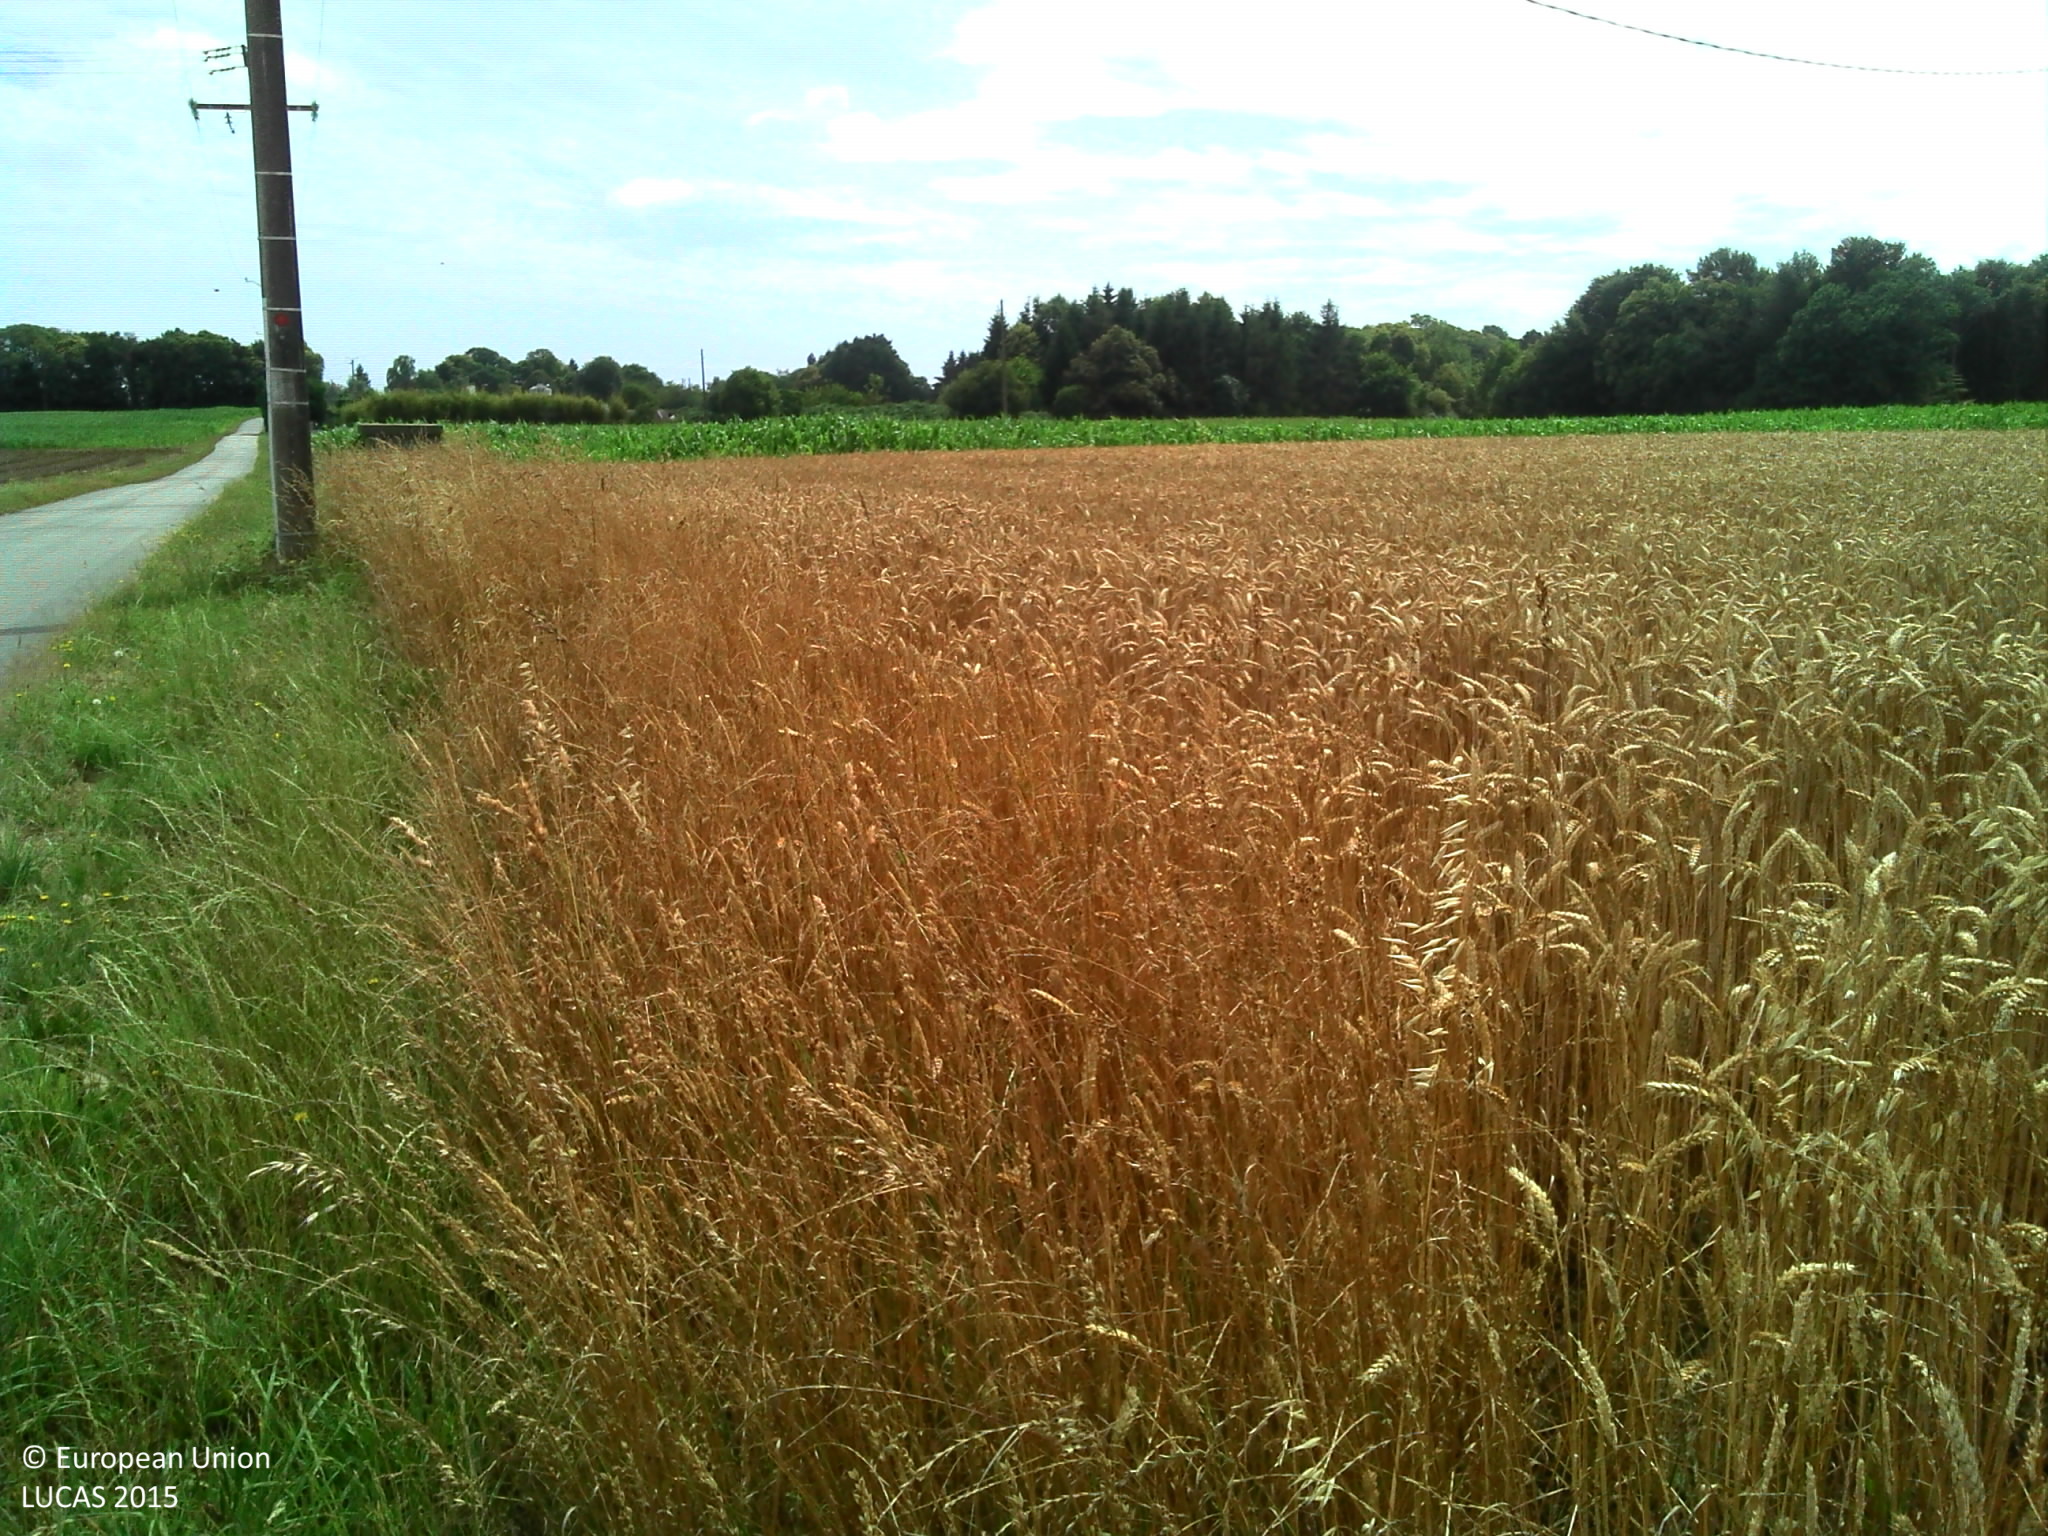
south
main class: Cropland
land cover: Common wheat
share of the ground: > 75 %
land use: Agriculture (excluding fallow land and kitchen gardens)
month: July
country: FR
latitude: 47.8229
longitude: -3.5267
